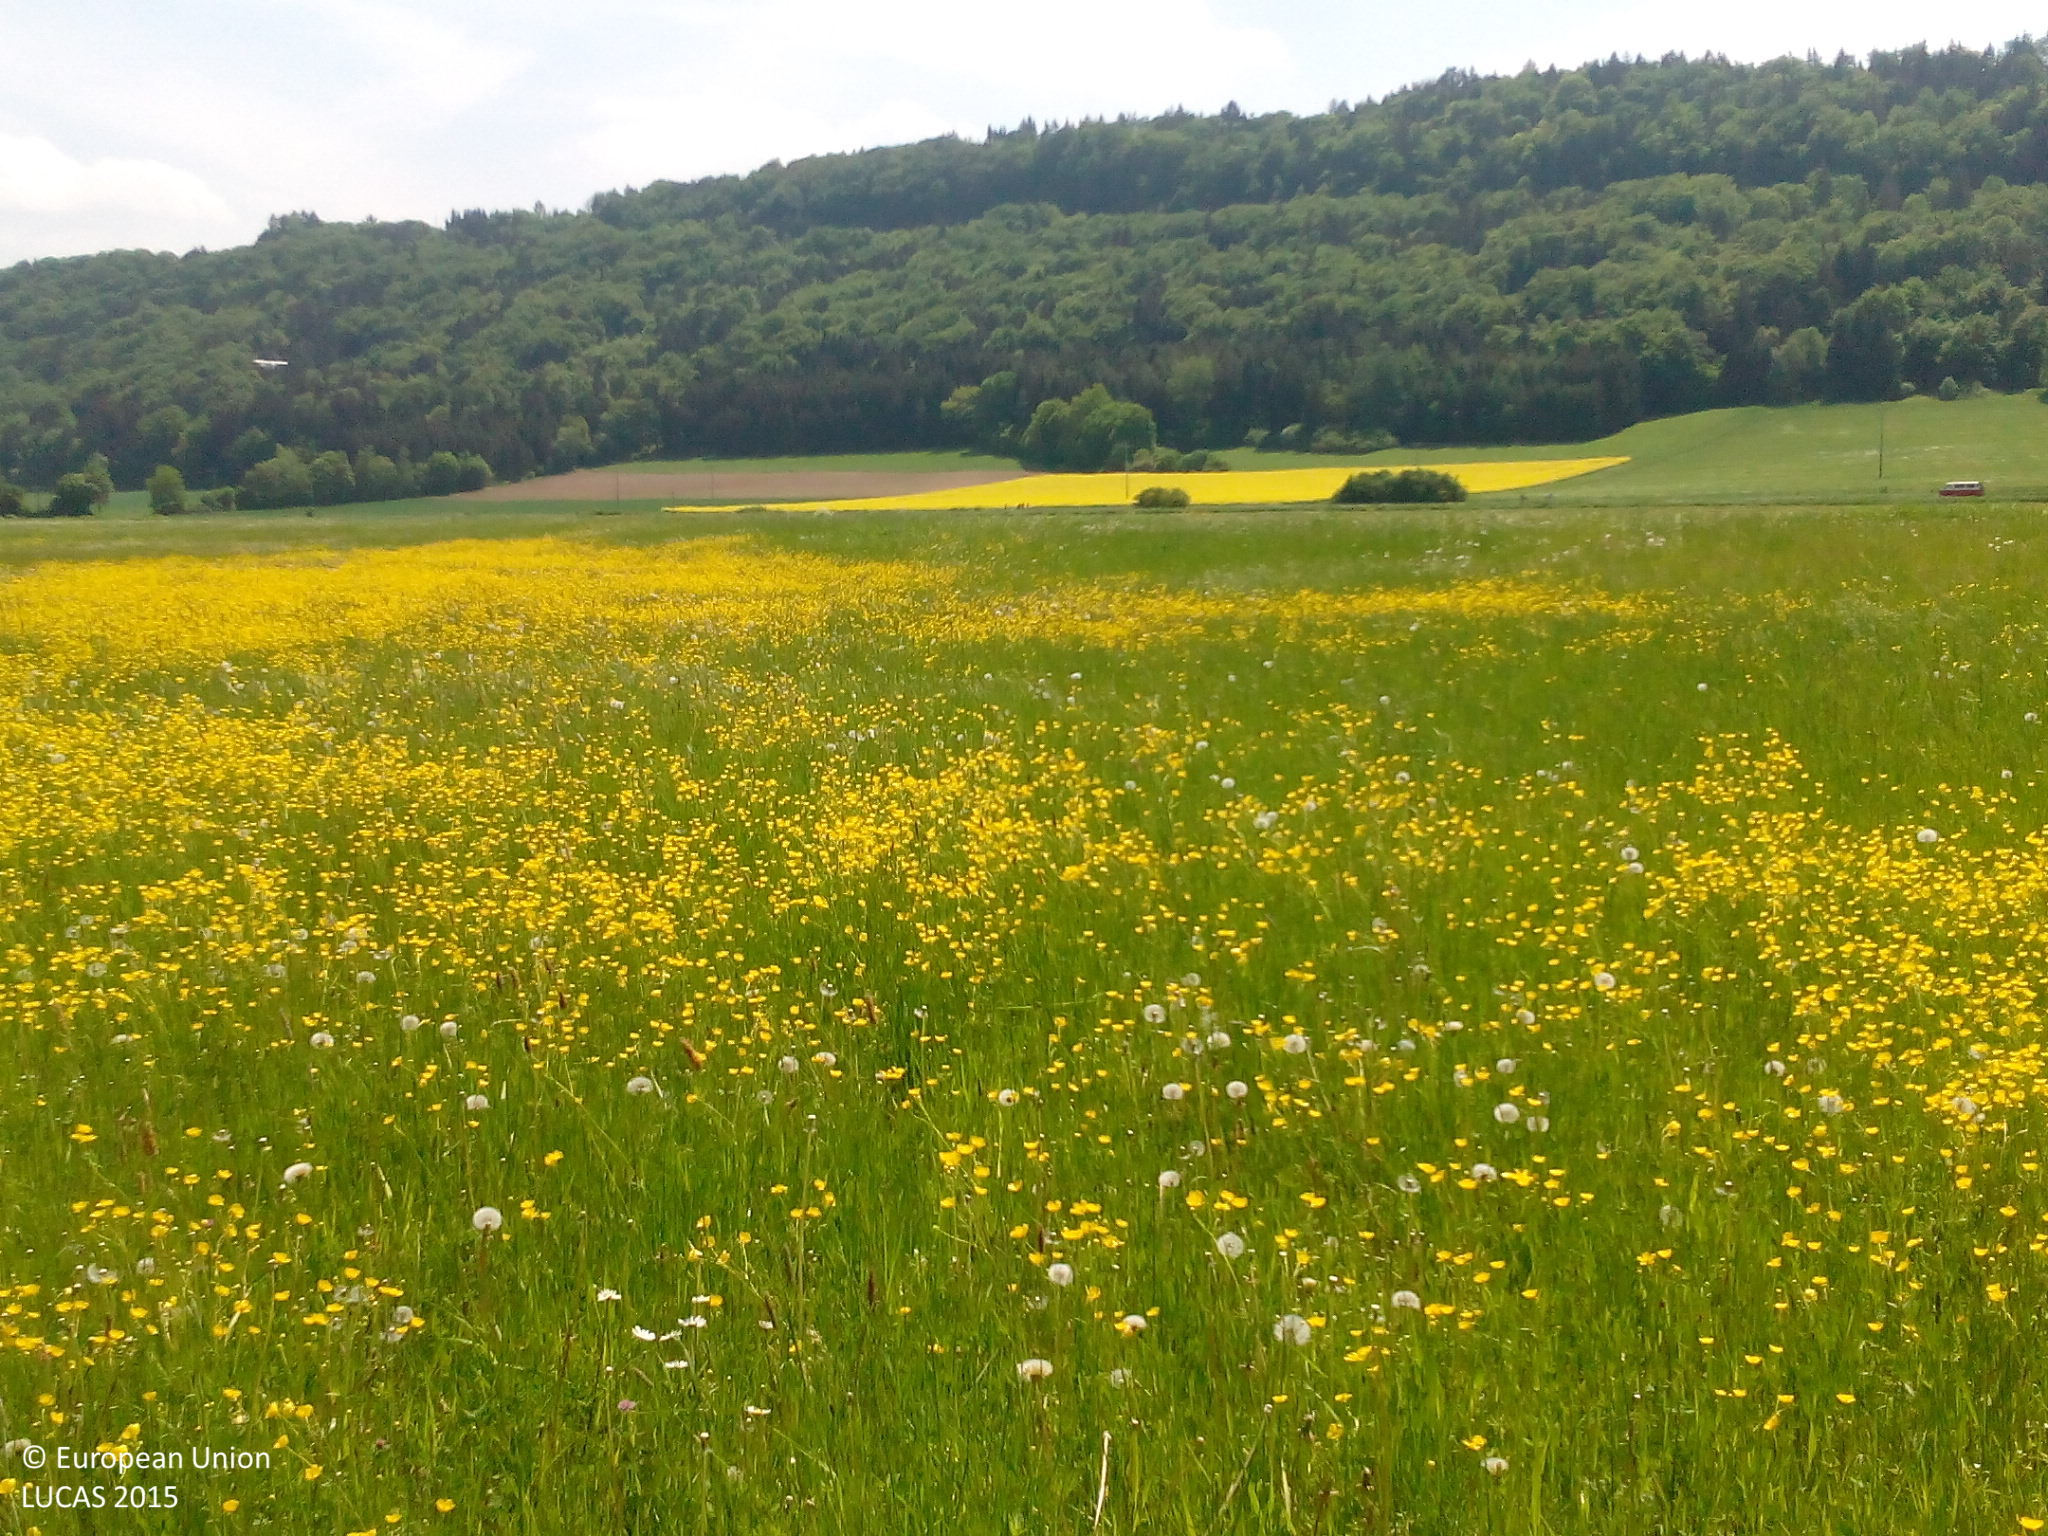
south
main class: Grassland
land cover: Grassland without tree/shrub cover
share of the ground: > 75 %
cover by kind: herbaceous plants 95 %, lichens and mosses 5 %
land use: Agriculture (excluding fallow land and kitchen gardens)
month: May
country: DE
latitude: 49.0232
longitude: 11.4900
